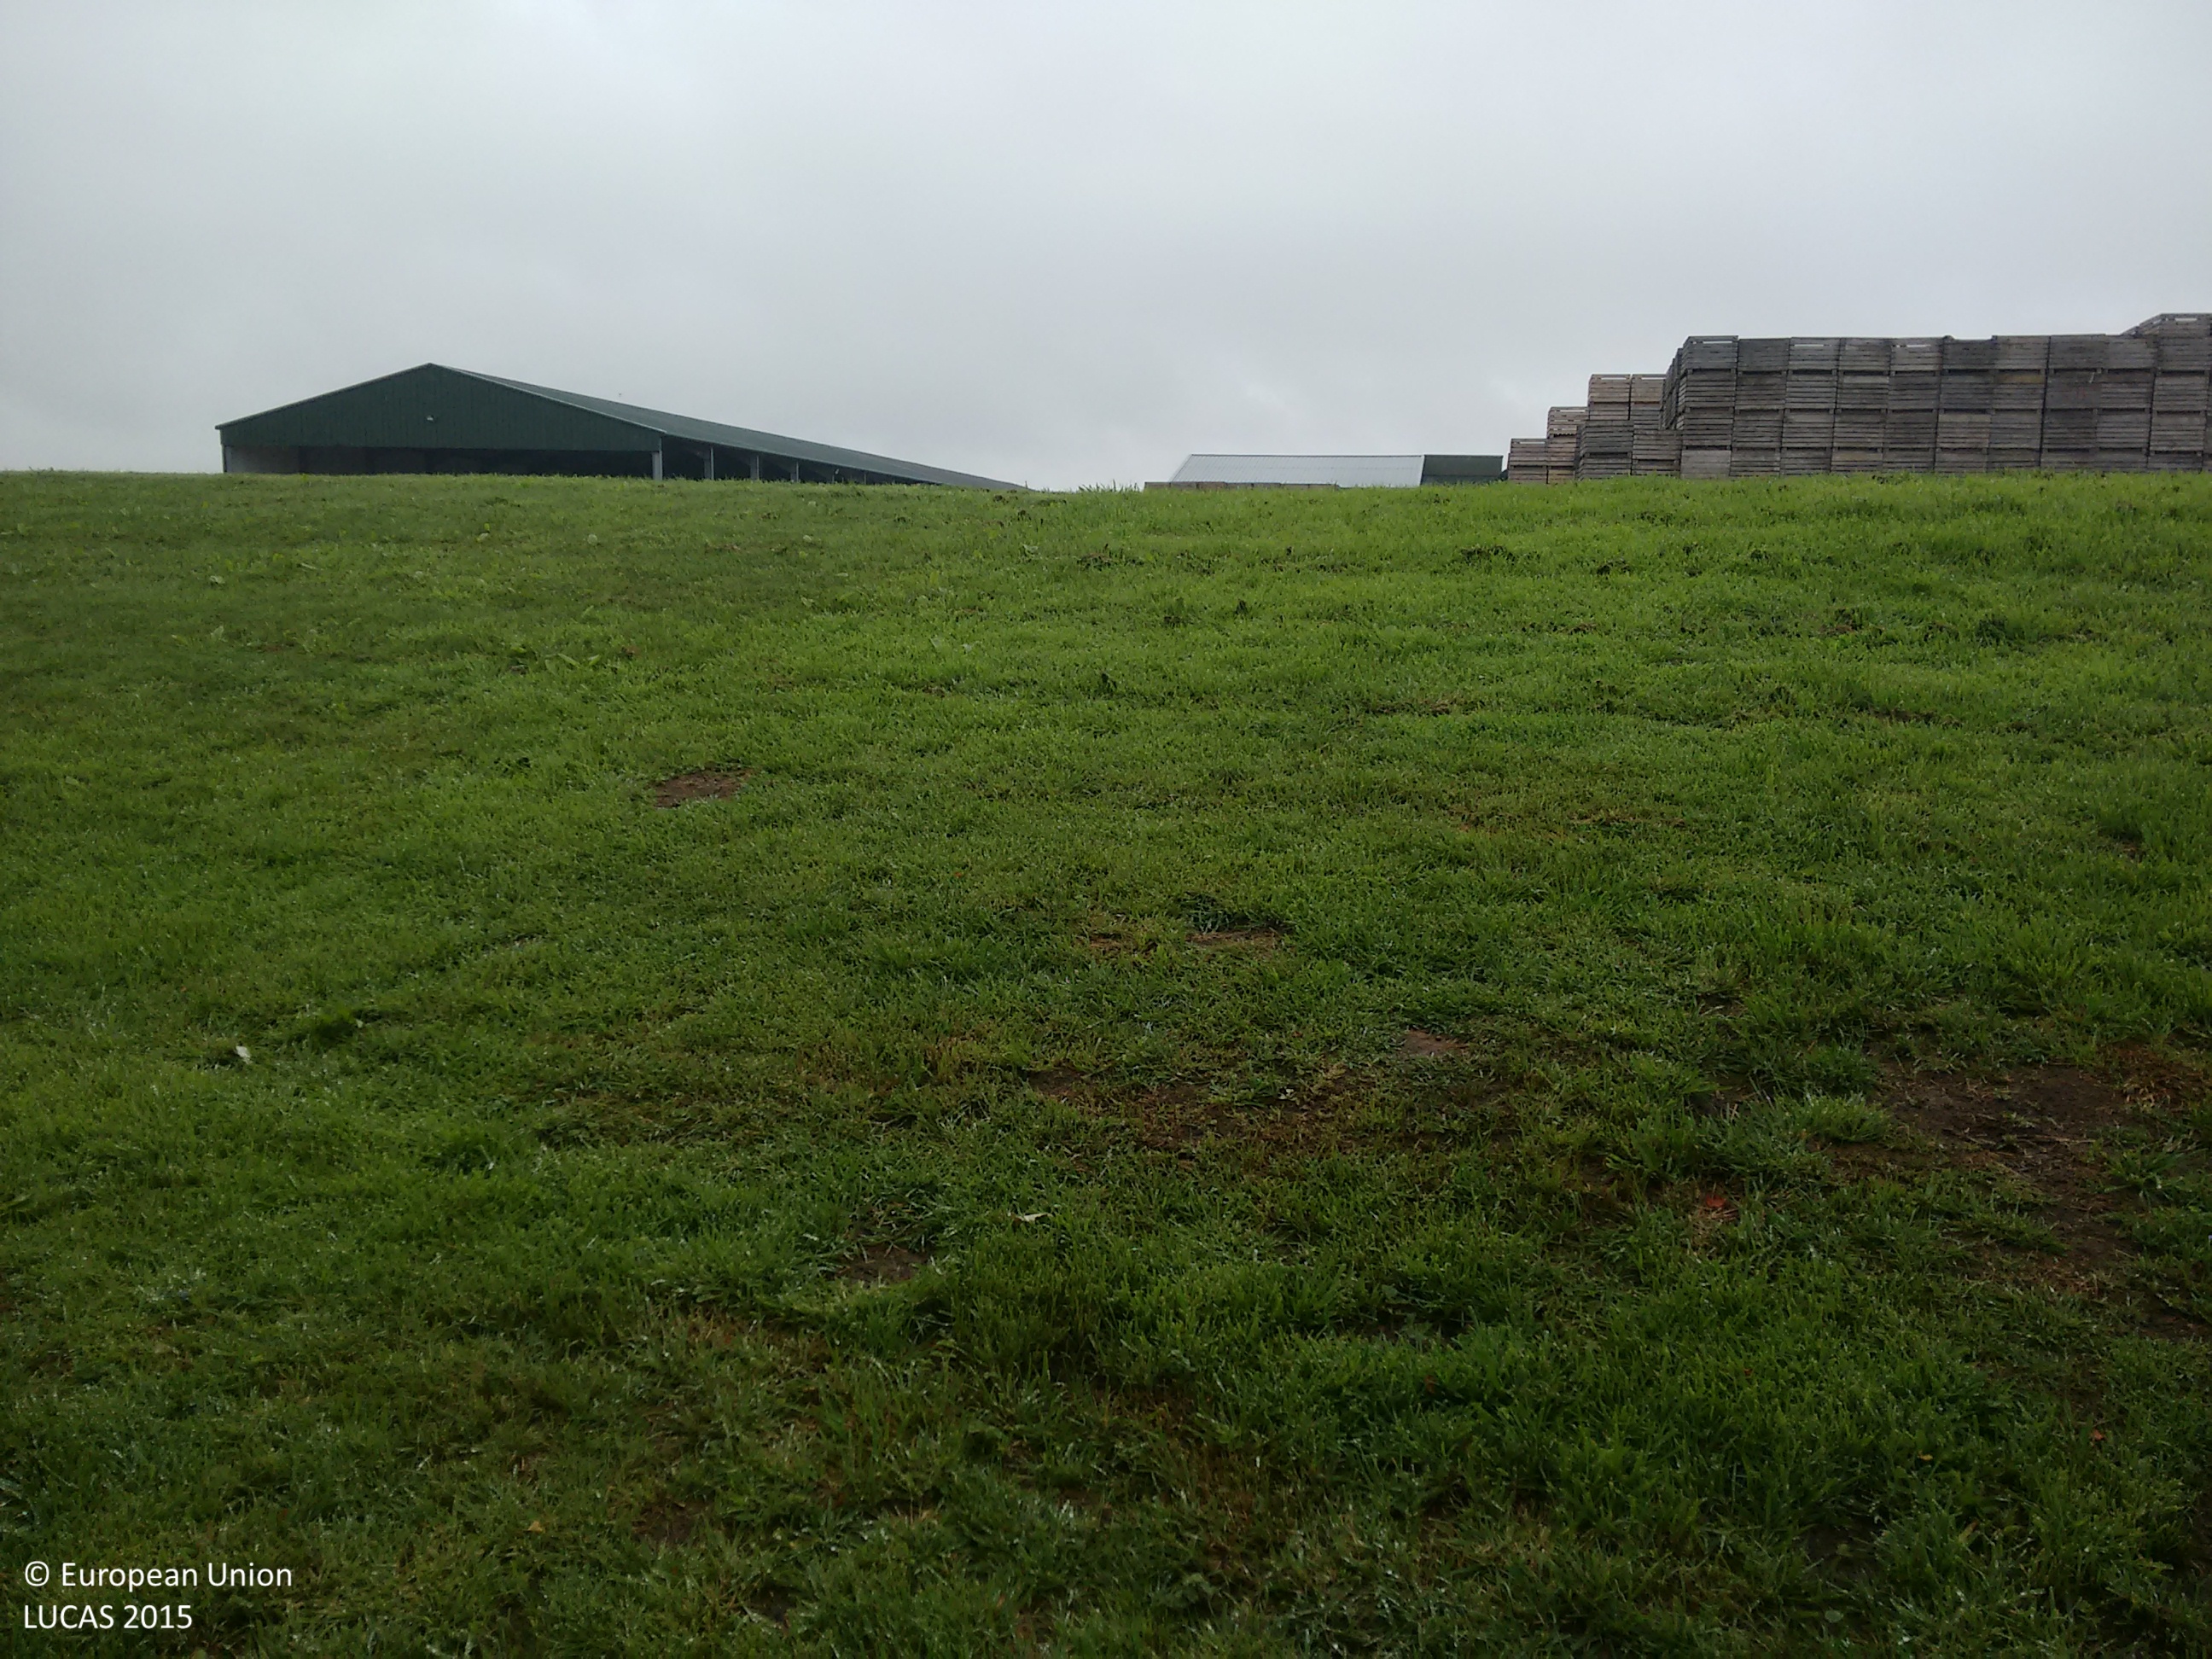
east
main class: Grassland
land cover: Grassland without tree/shrub cover
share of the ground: > 75 %
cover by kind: herbaceous plants 100 %
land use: Agriculture (excluding fallow land and kitchen gardens)
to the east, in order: Grassland without tree/shrub cover; Artificial constructions in urban areas
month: July
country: GB
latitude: 52.2456
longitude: -2.7991
